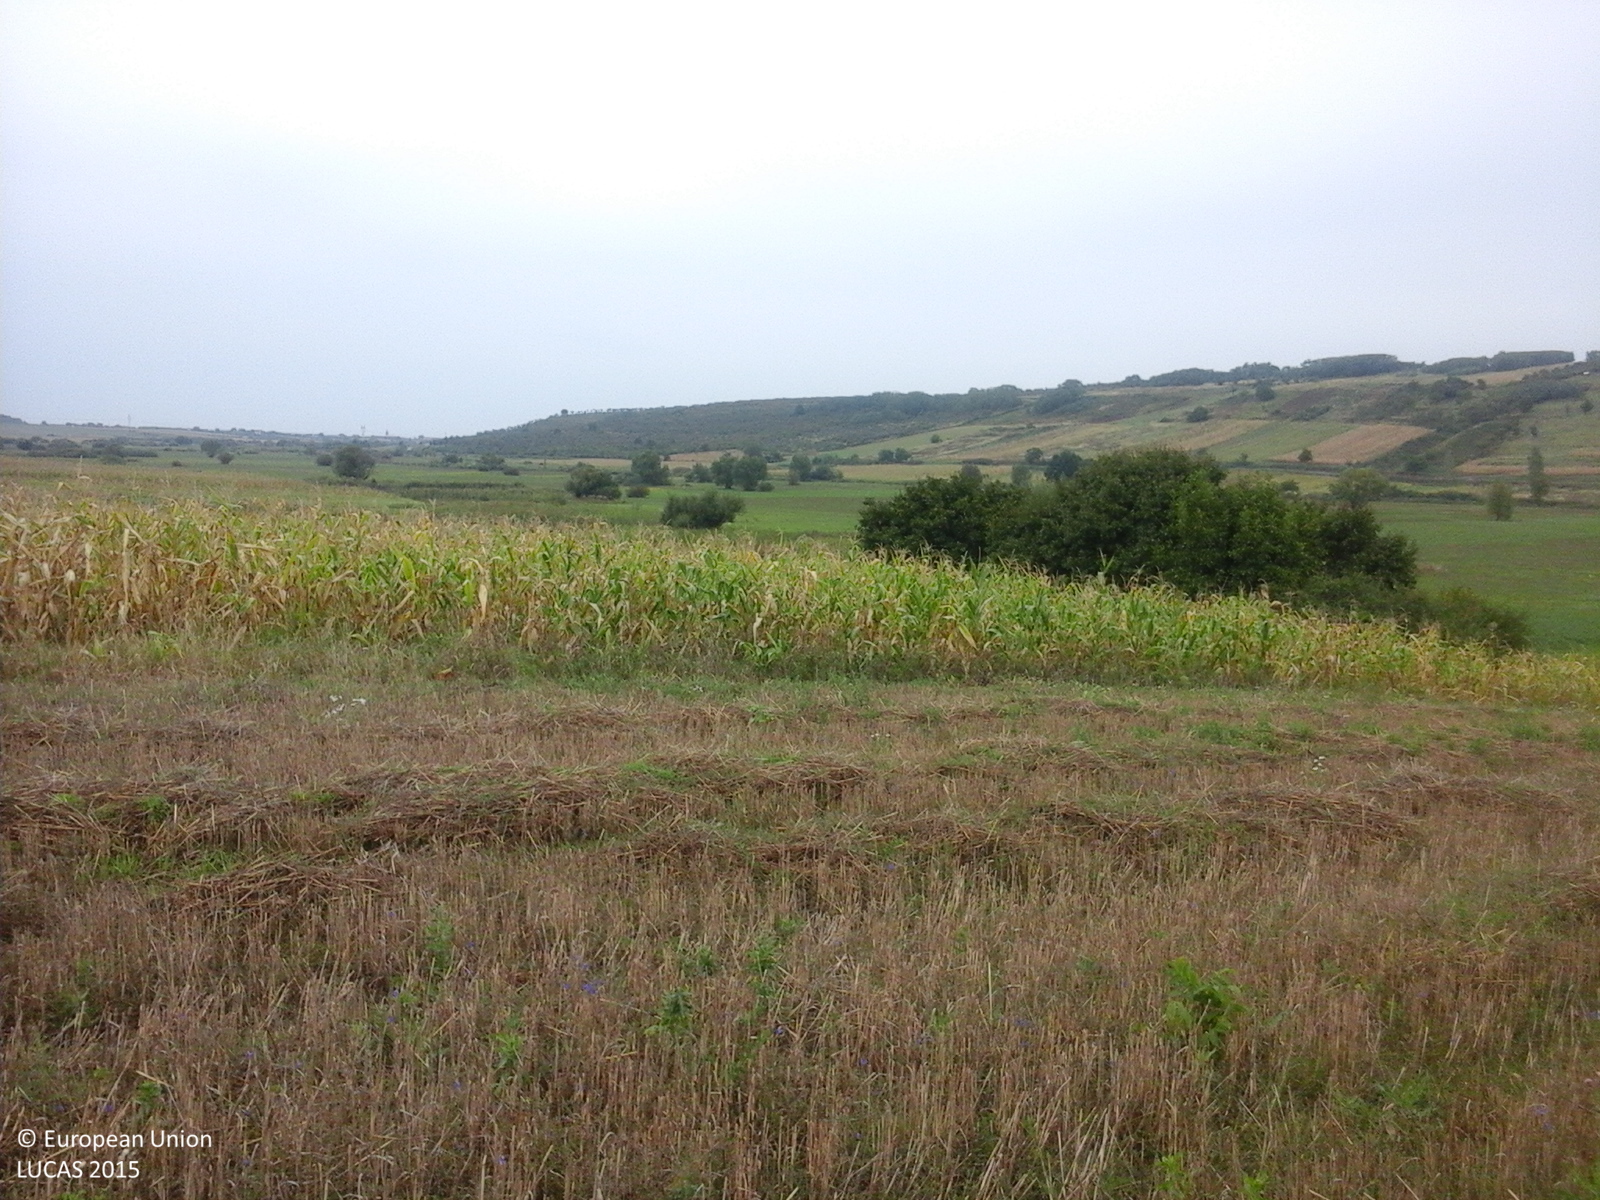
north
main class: Cropland
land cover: Common wheat
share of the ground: 50 - 75 %
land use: Agriculture (excluding fallow land and kitchen gardens)
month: September
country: RO
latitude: 47.4291
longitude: 22.5593
